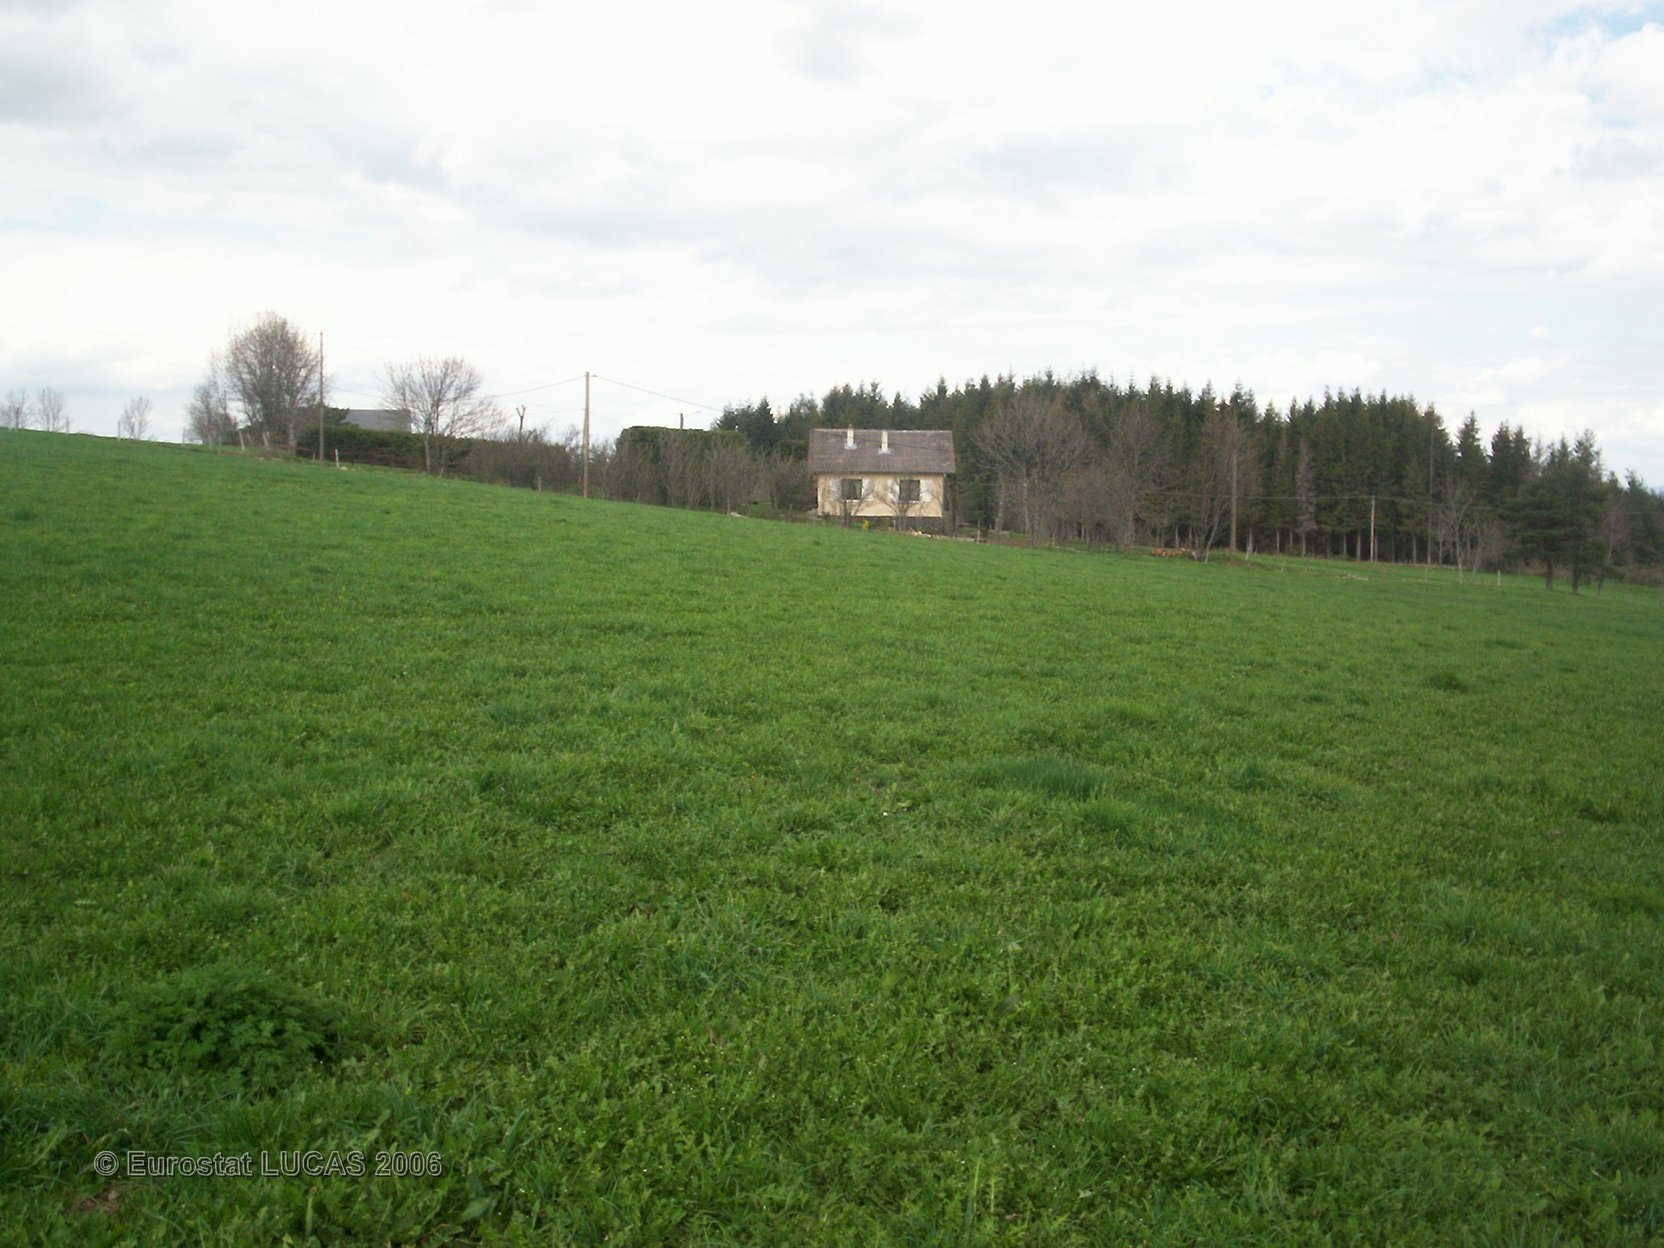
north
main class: Grassland
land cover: Grassland without tree/shrub cover
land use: Agriculture (excluding fallow land and kitchen gardens)
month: April
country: FR
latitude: 45.0919
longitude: 4.1978
